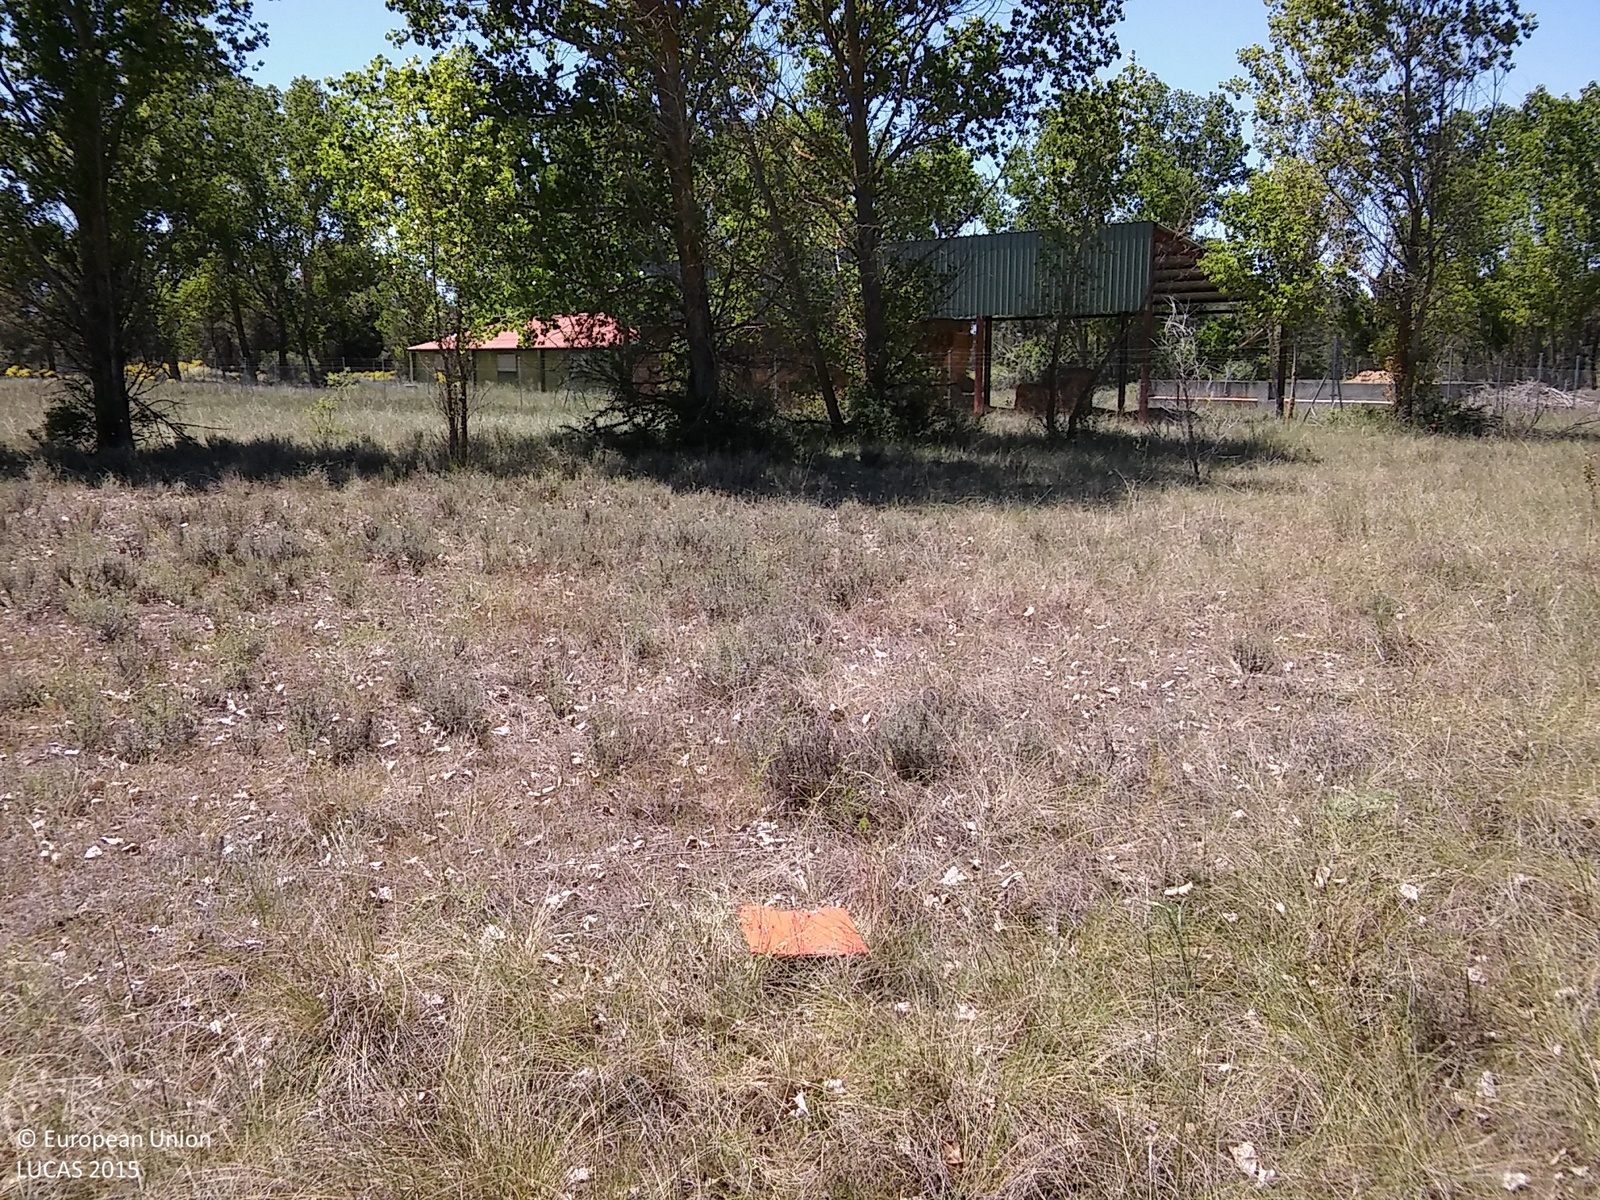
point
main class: Grassland
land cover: Grassland without tree/shrub cover
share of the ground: > 75 %
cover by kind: herbaceous plants 95 %, shrubs 5 %
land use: Semi-natural and natural areas not in use
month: May
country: ES
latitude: 41.2269
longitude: -4.0702
